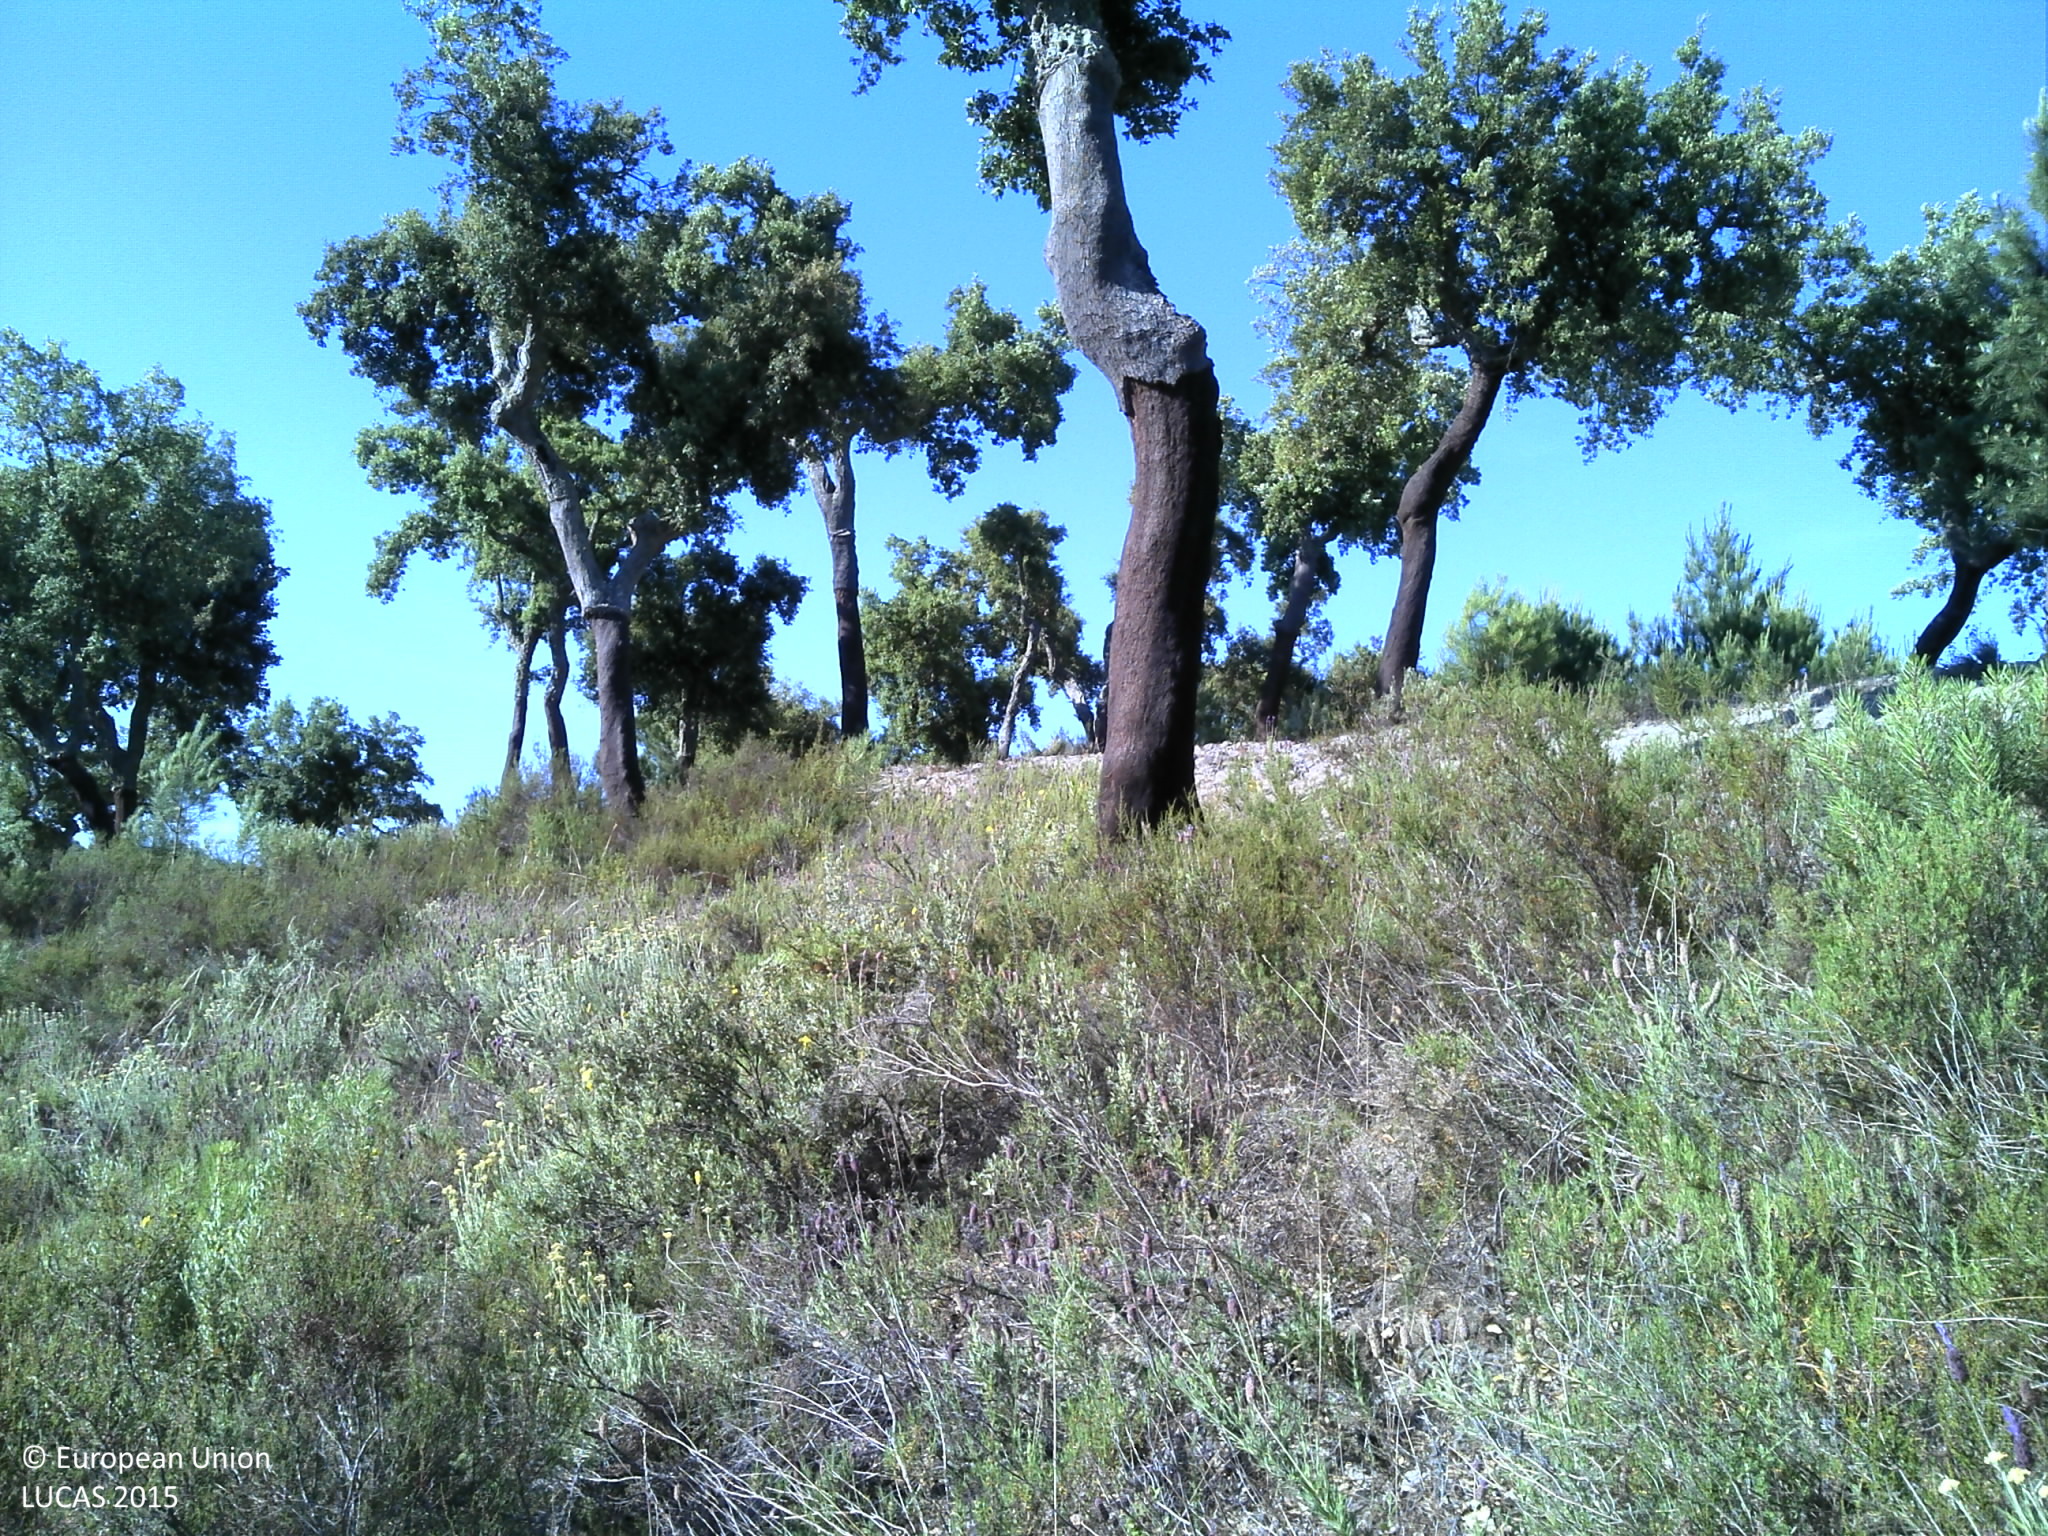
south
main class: Woodland
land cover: Broadleaved woodland
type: broadleaved evergreen forest
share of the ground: 25 - 50 %
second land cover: Shrubland without tree cover
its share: 50 - 75 %
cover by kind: broadleaved forest trees 50 %, shrubs 20 %, unconsolidated bare surface 20 %, herbaceous plants 10 %
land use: Forestry
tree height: > 5 m
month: May
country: PT
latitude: 39.1771
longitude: -8.0072
